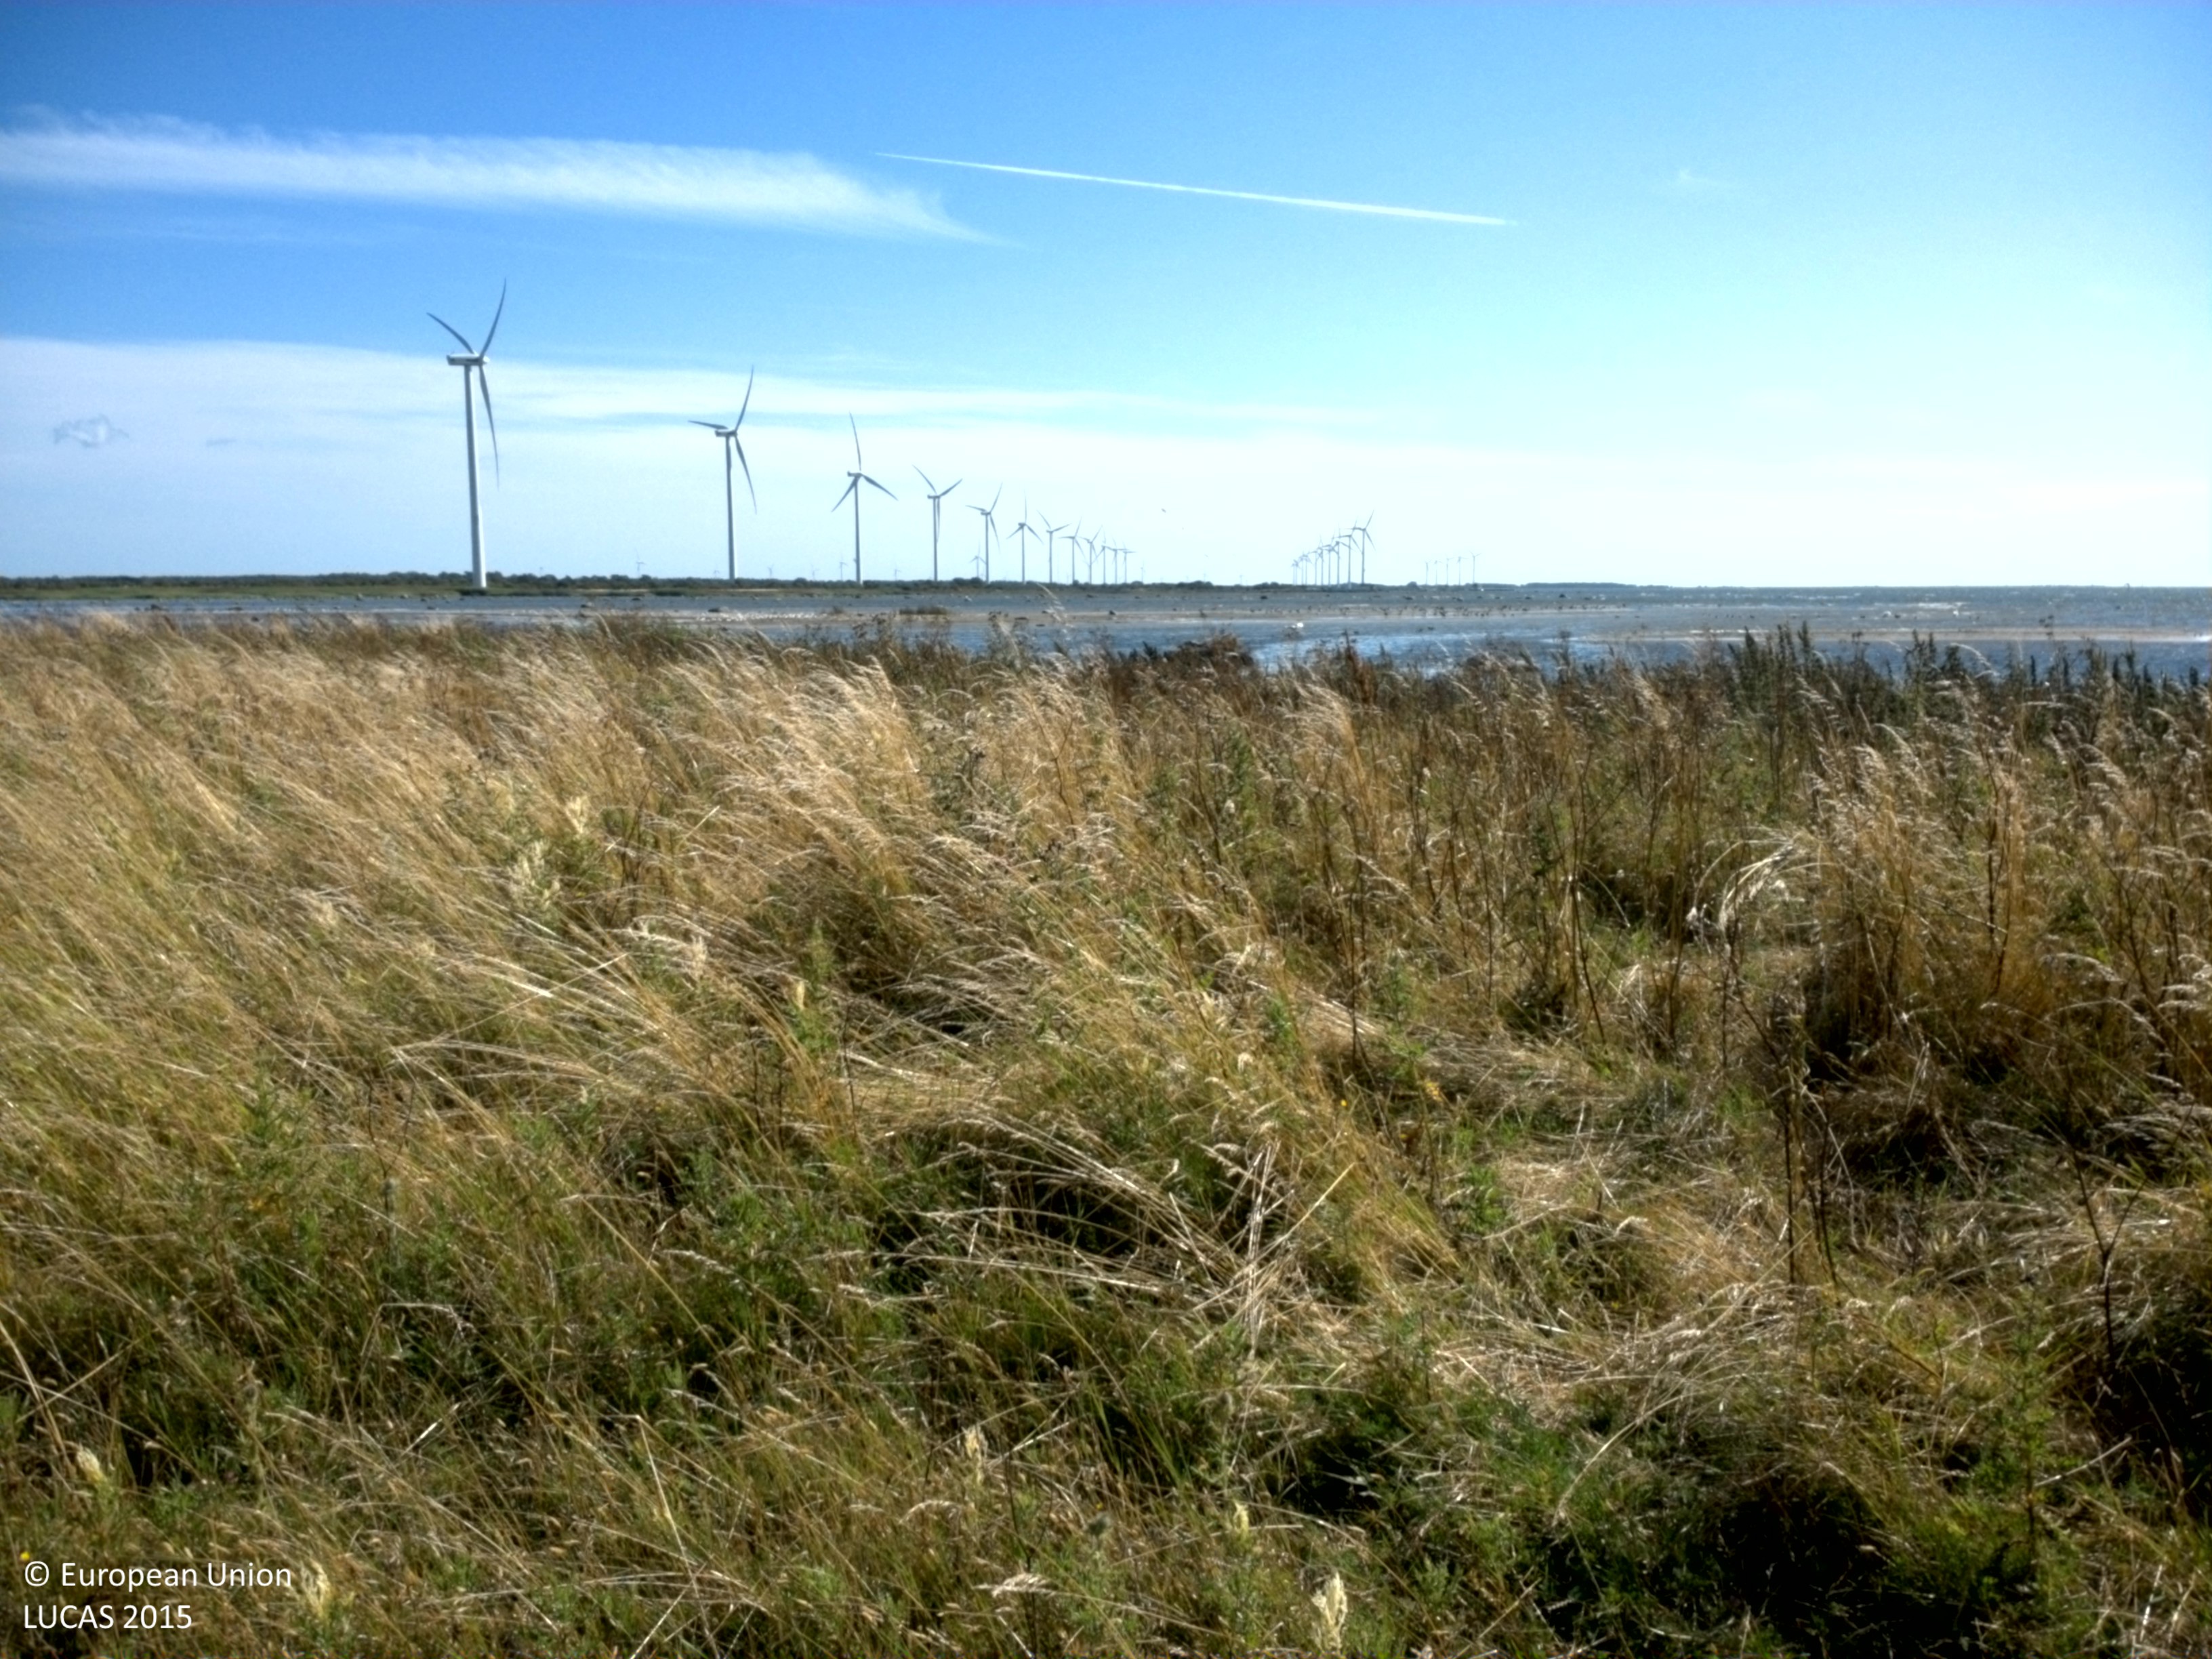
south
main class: Grassland
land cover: Grassland without tree/shrub cover
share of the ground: > 75 %
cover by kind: herbaceous plants 100 %
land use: Agriculture (excluding fallow land and kitchen gardens)
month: July
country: SE
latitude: 57.1176
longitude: 18.2160
